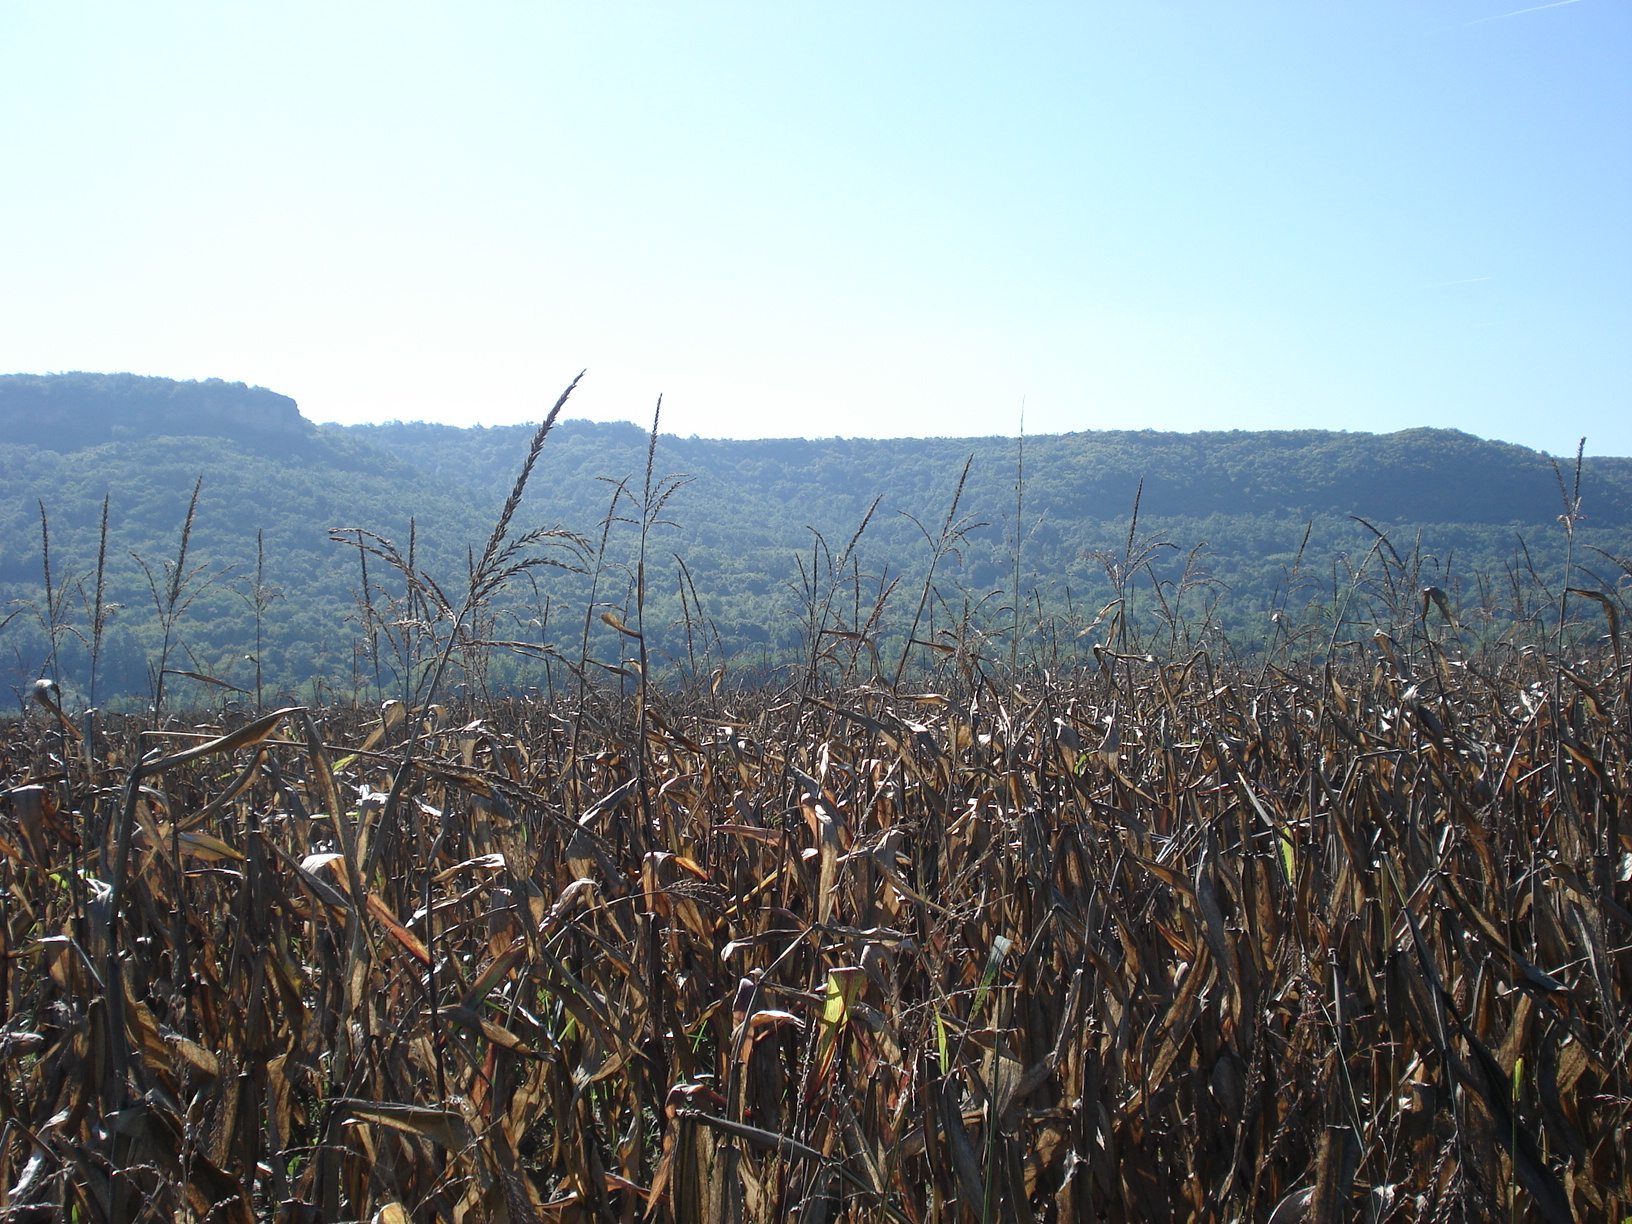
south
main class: Cropland
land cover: Maize
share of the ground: > 75 %
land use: Agriculture (excluding fallow land and kitchen gardens)
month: October
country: BG
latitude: 43.1940
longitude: 25.2707
